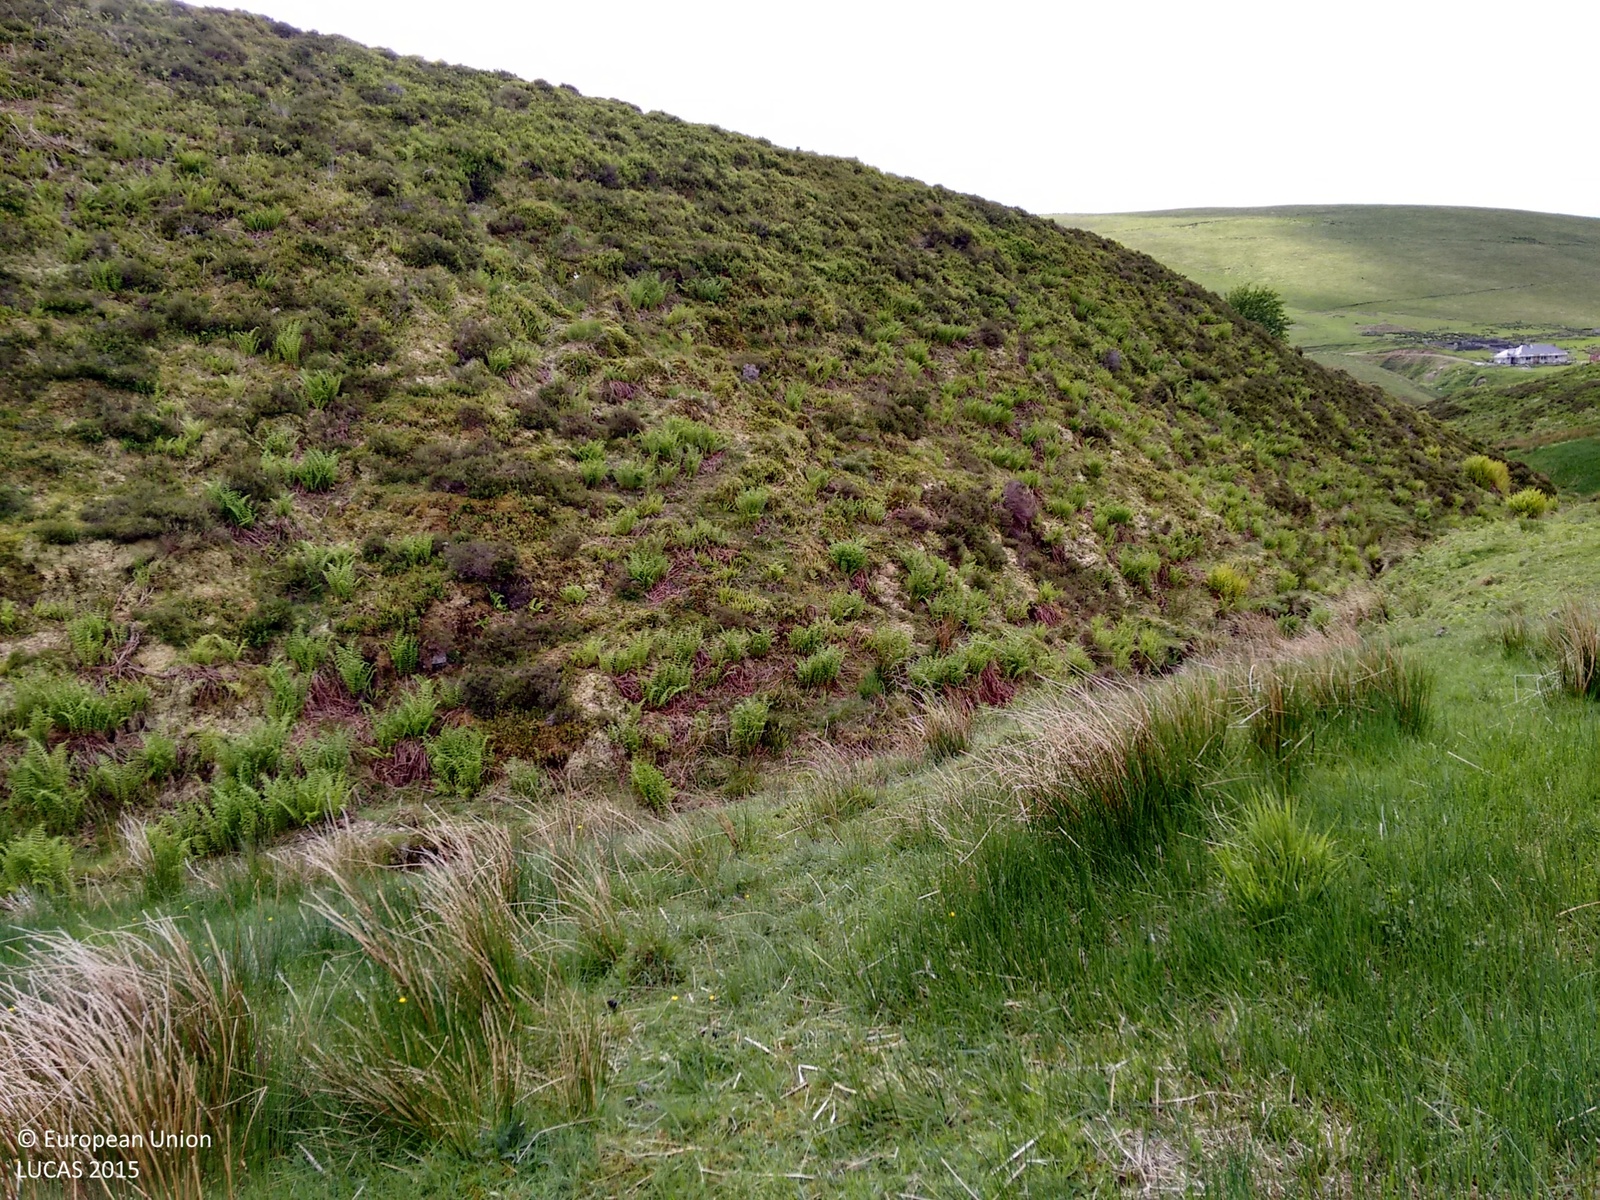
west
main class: Grassland
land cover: Grassland without tree/shrub cover
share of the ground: > 75 %
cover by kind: herbaceous plants 90 %, shrubs 5 %, lichens and mosses 5 %
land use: Agriculture (excluding fallow land and kitchen gardens)
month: June
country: GB
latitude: 55.4174
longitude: -3.8137
